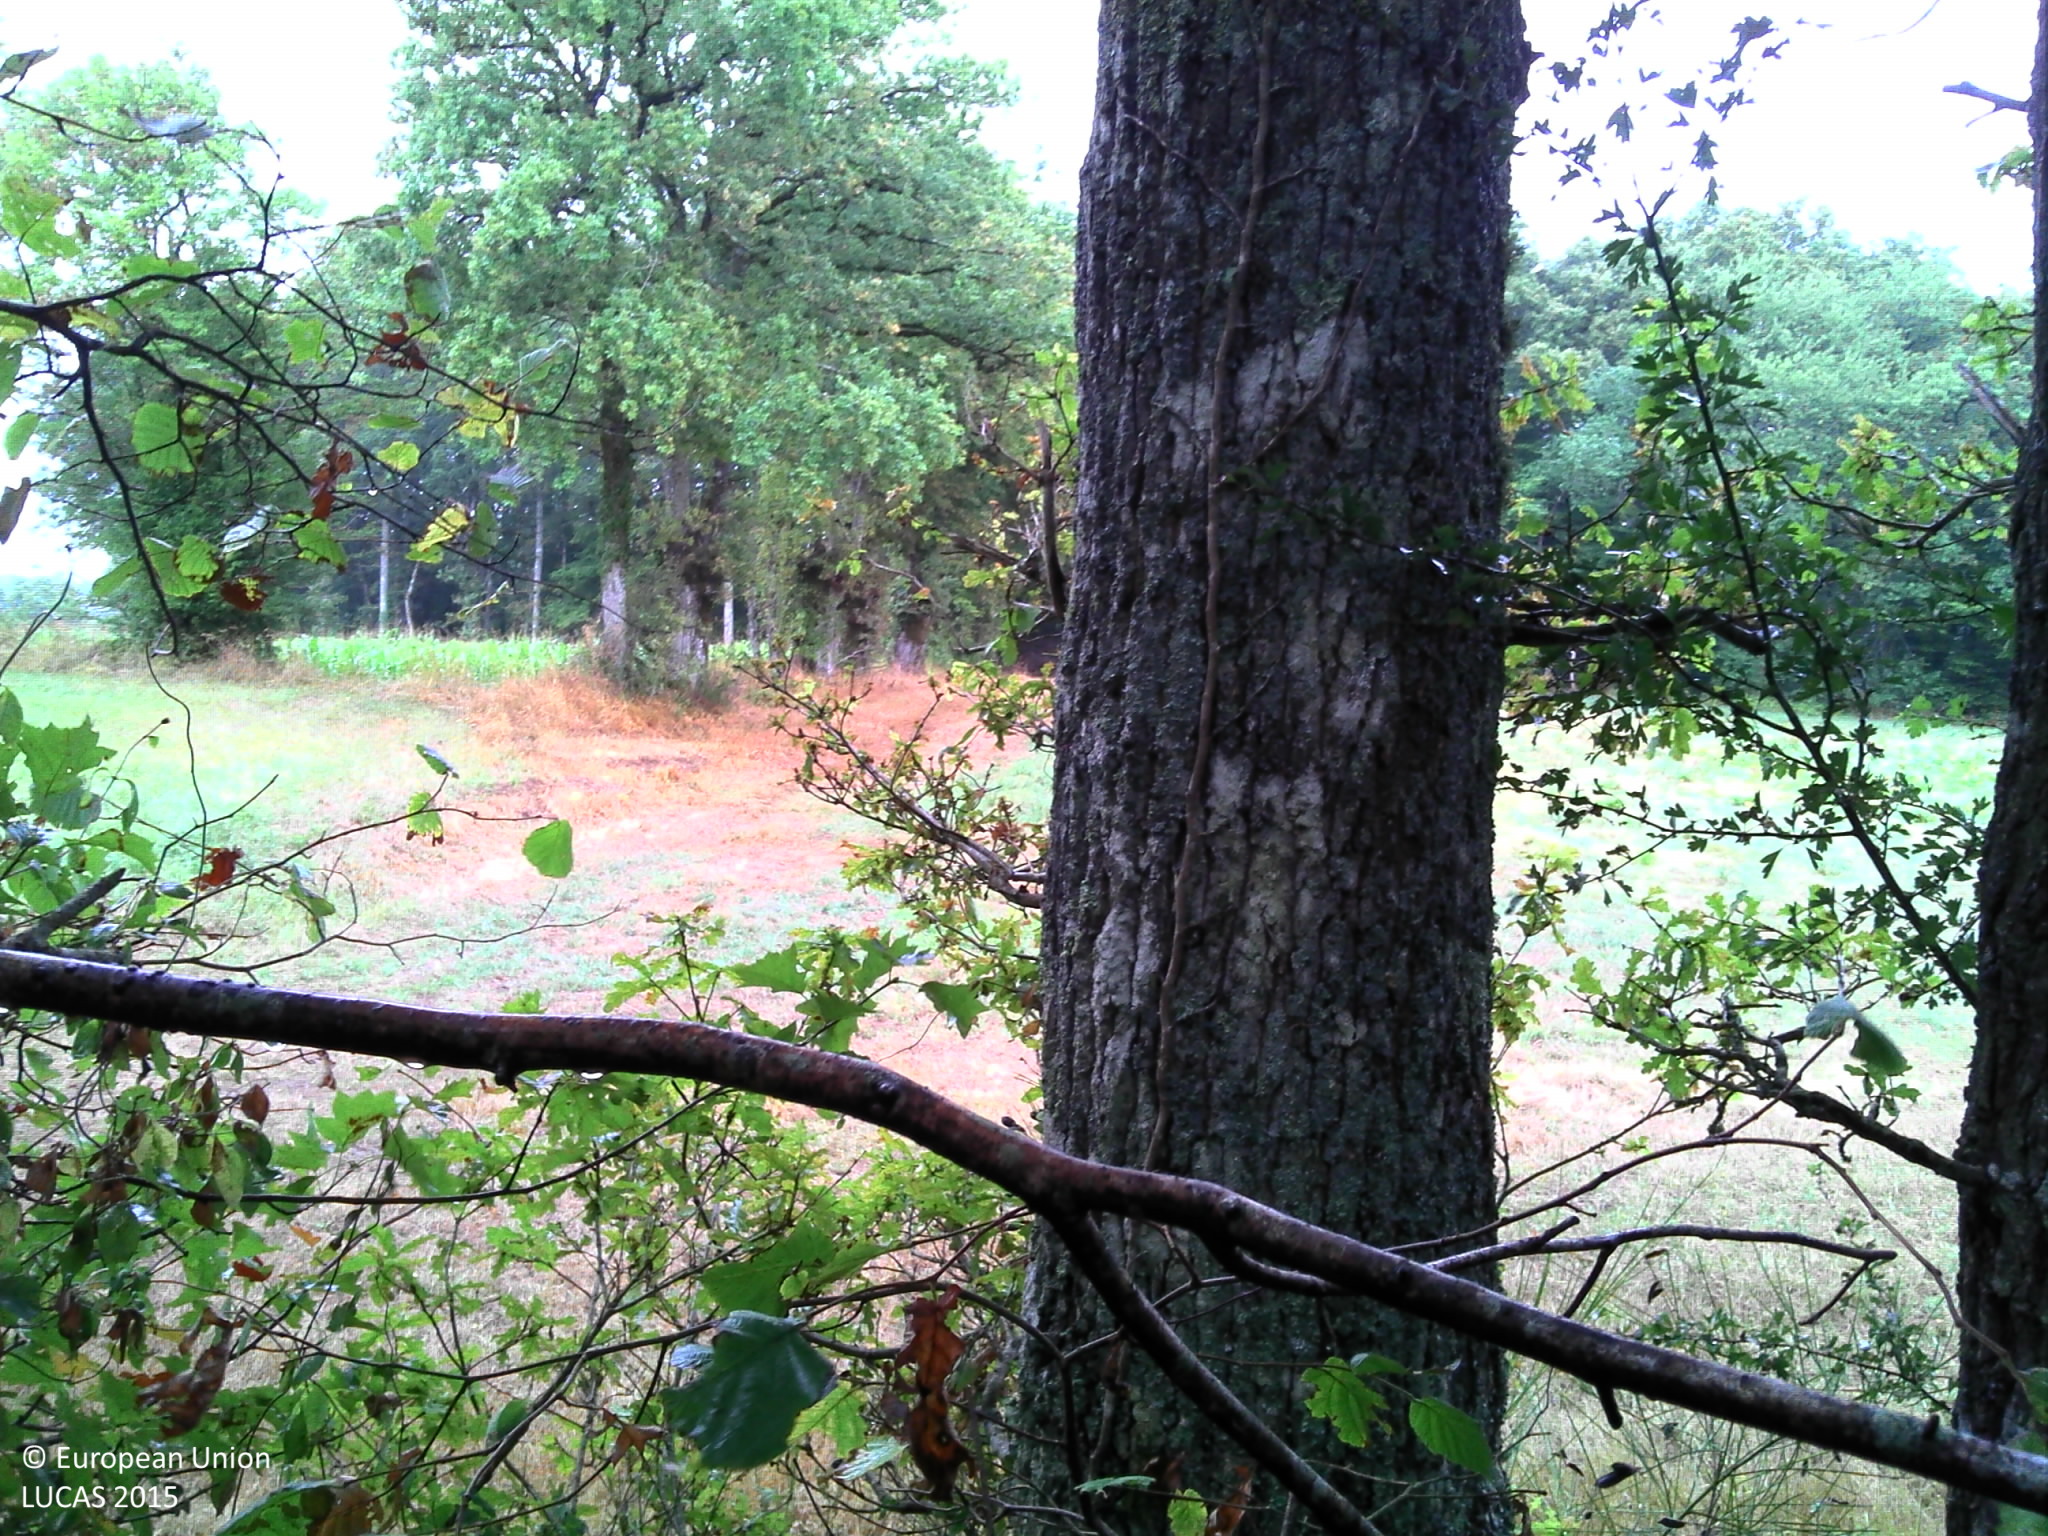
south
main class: Grassland
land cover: Grassland without tree/shrub cover
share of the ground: > 75 %
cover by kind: herbaceous plants 100 %
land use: Agriculture (excluding fallow land and kitchen gardens)
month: August
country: FR
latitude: 47.6127
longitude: 3.1432
